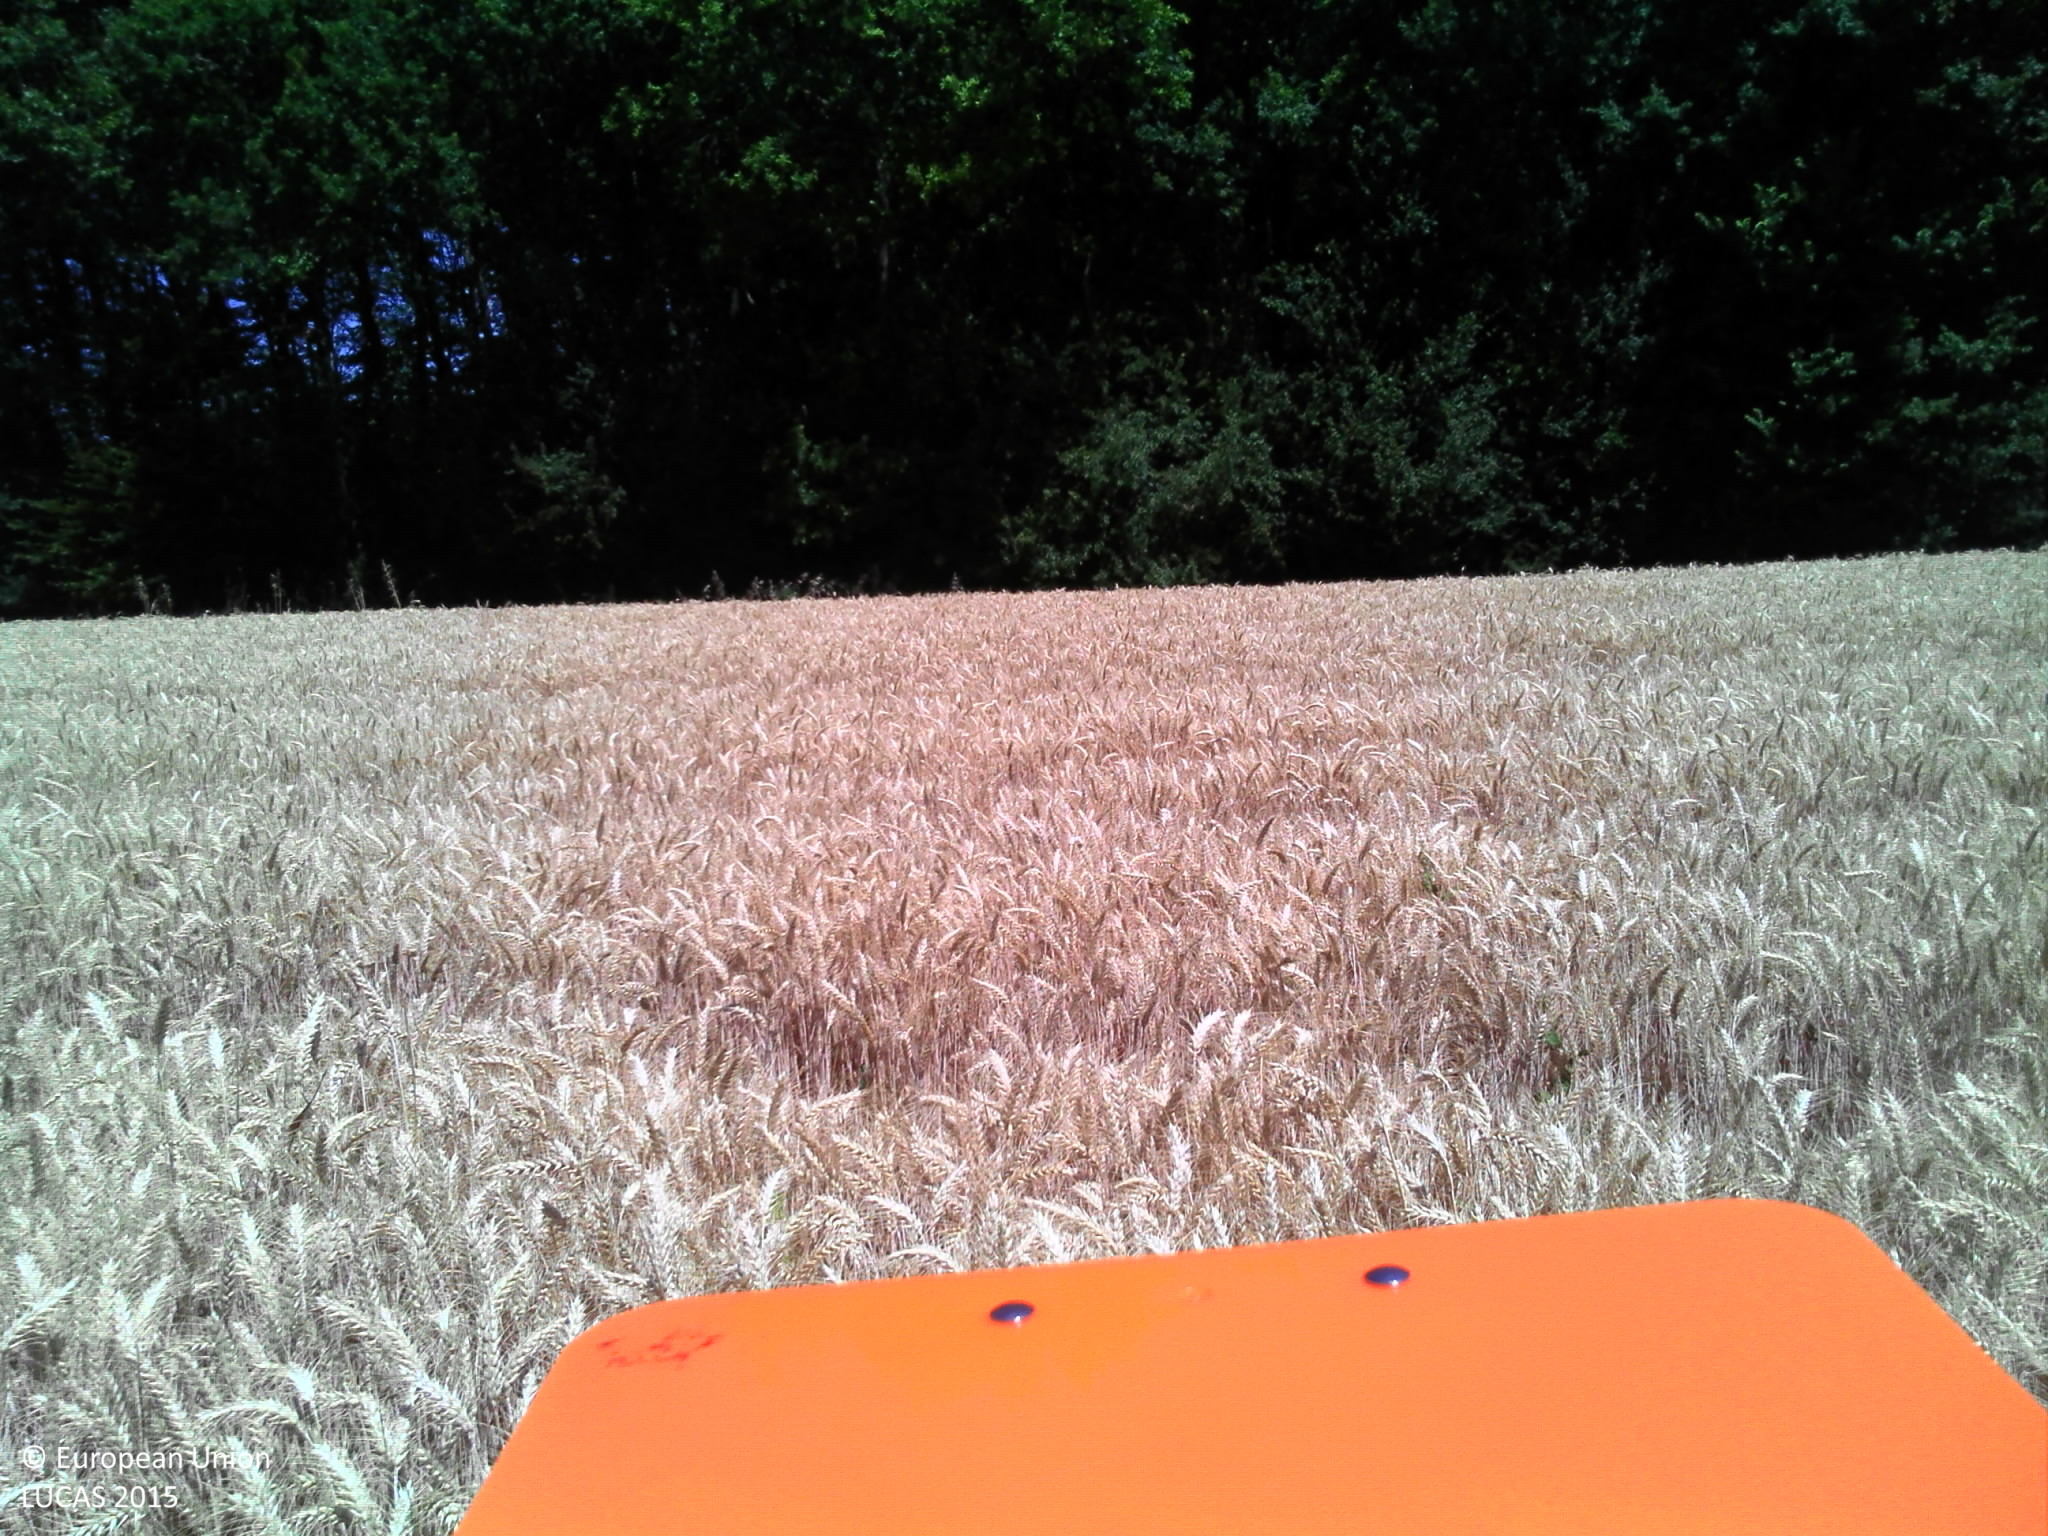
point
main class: Cropland
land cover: Common wheat
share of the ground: > 75 %
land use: Agriculture (excluding fallow land and kitchen gardens)
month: July
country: FR
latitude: 48.0378
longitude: 2.4659
